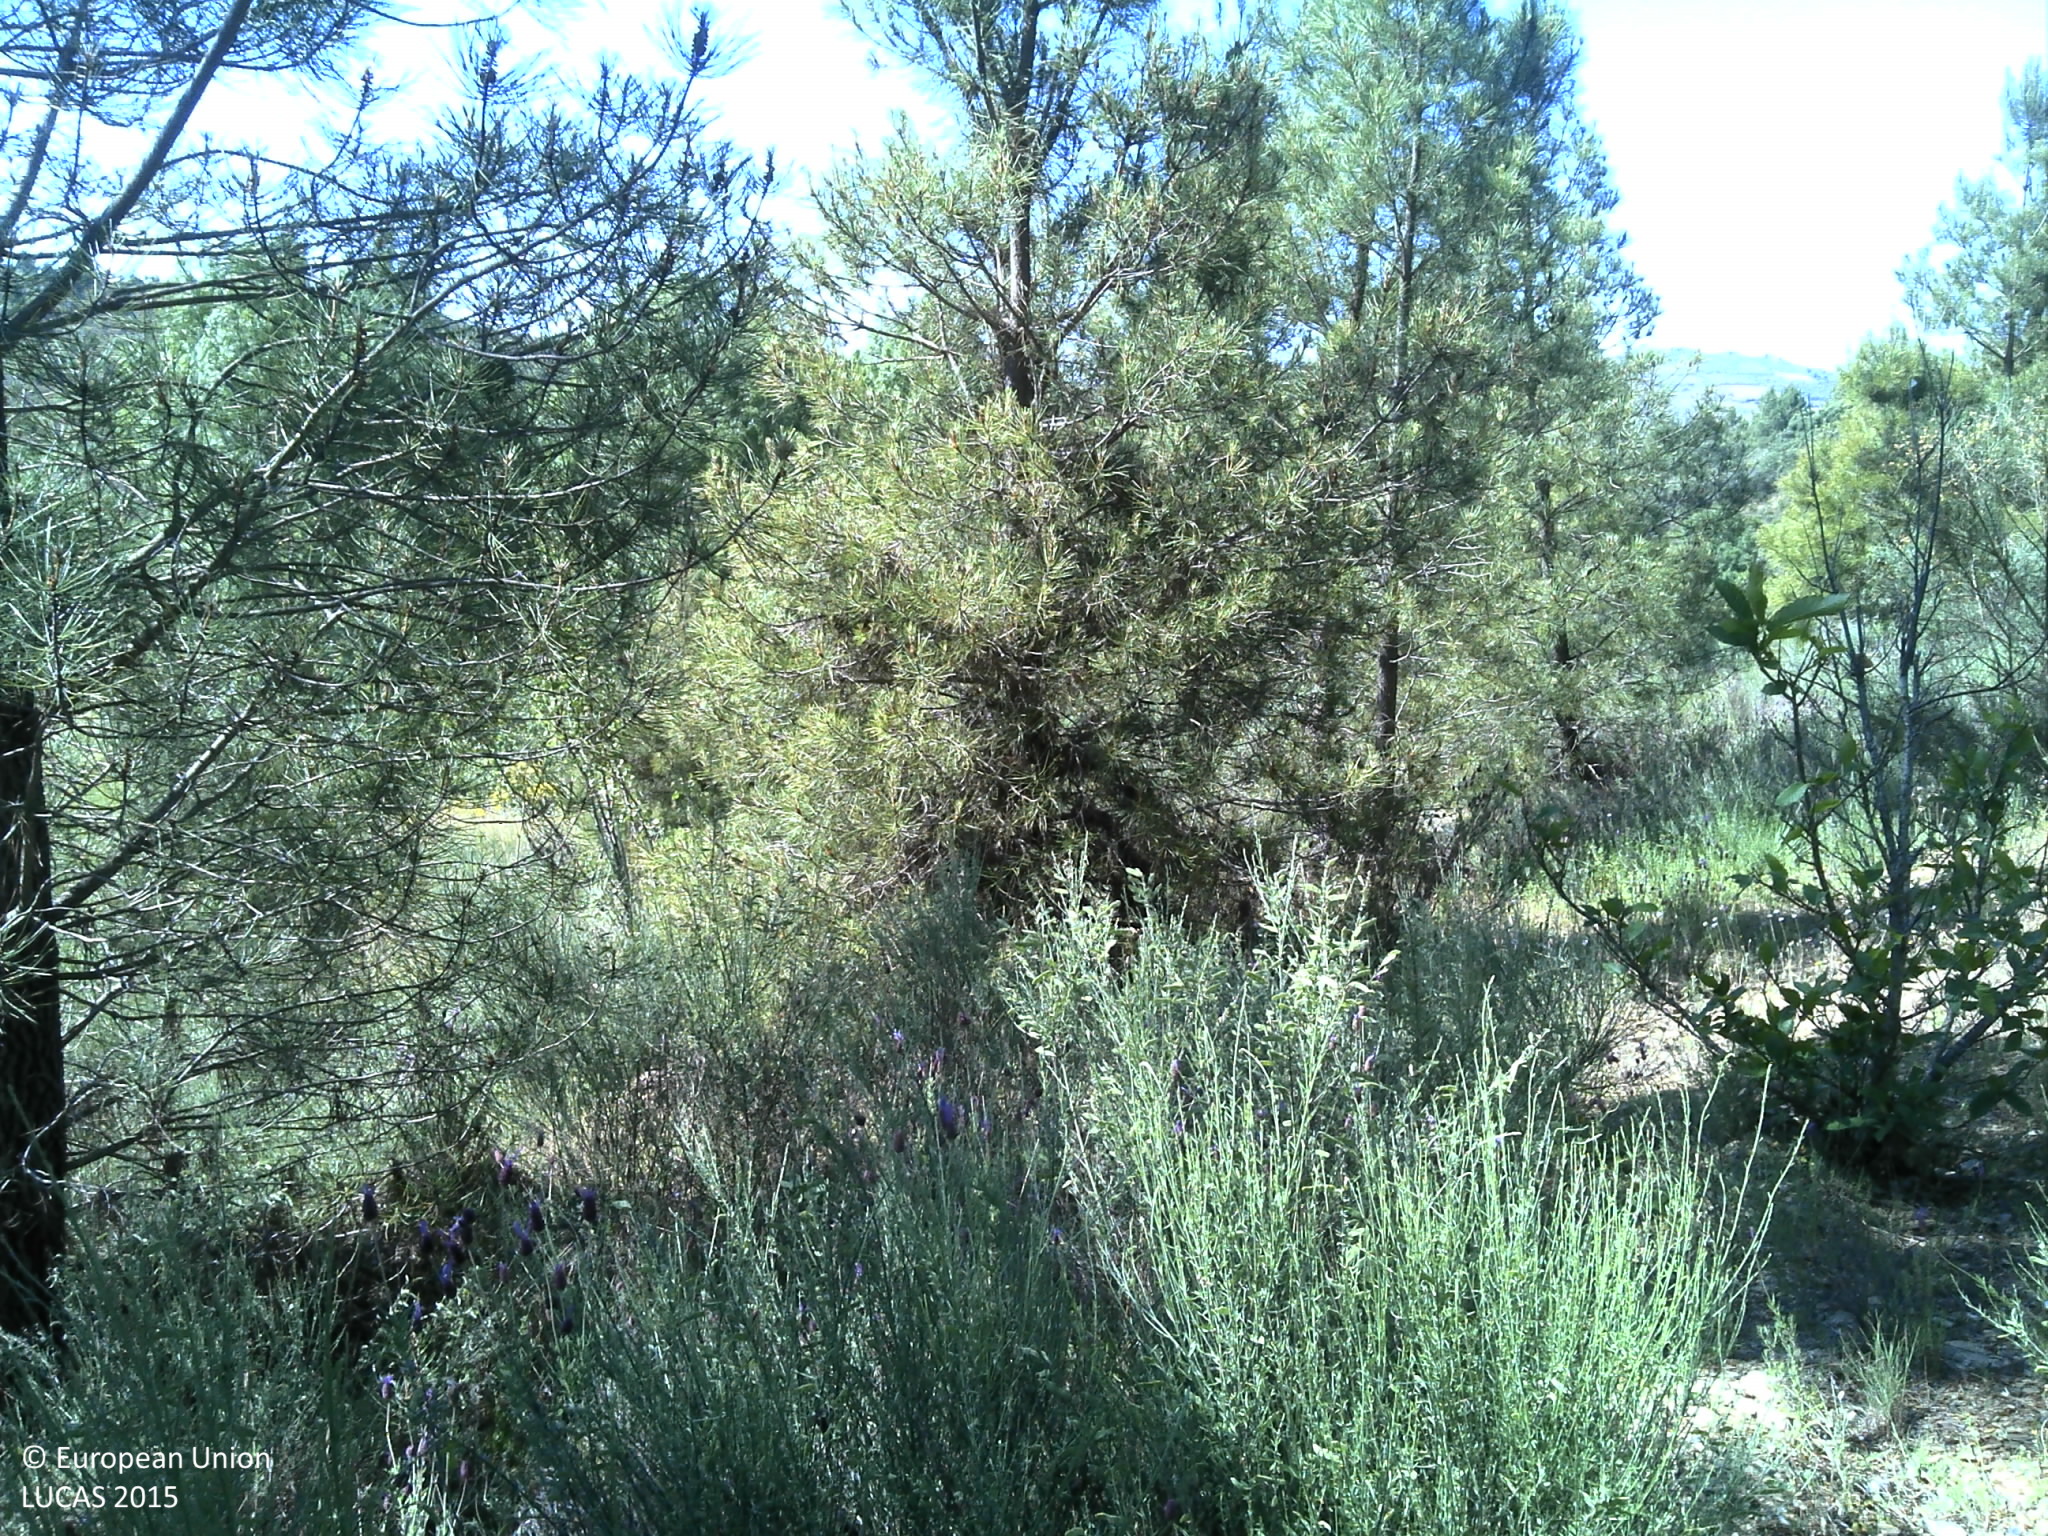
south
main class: Woodland
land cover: Pine dominated coniferous woodland
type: coniferous forest of the mediterranean region
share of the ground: 10 - 25 %
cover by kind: coniferous forest trees 20 %, shrubs 20 %, herbaceous plants 10 %, unconsolidated bare surface 10 %
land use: Forestry
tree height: > 5 m
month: May
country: PT
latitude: 41.5585
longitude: -6.5432
